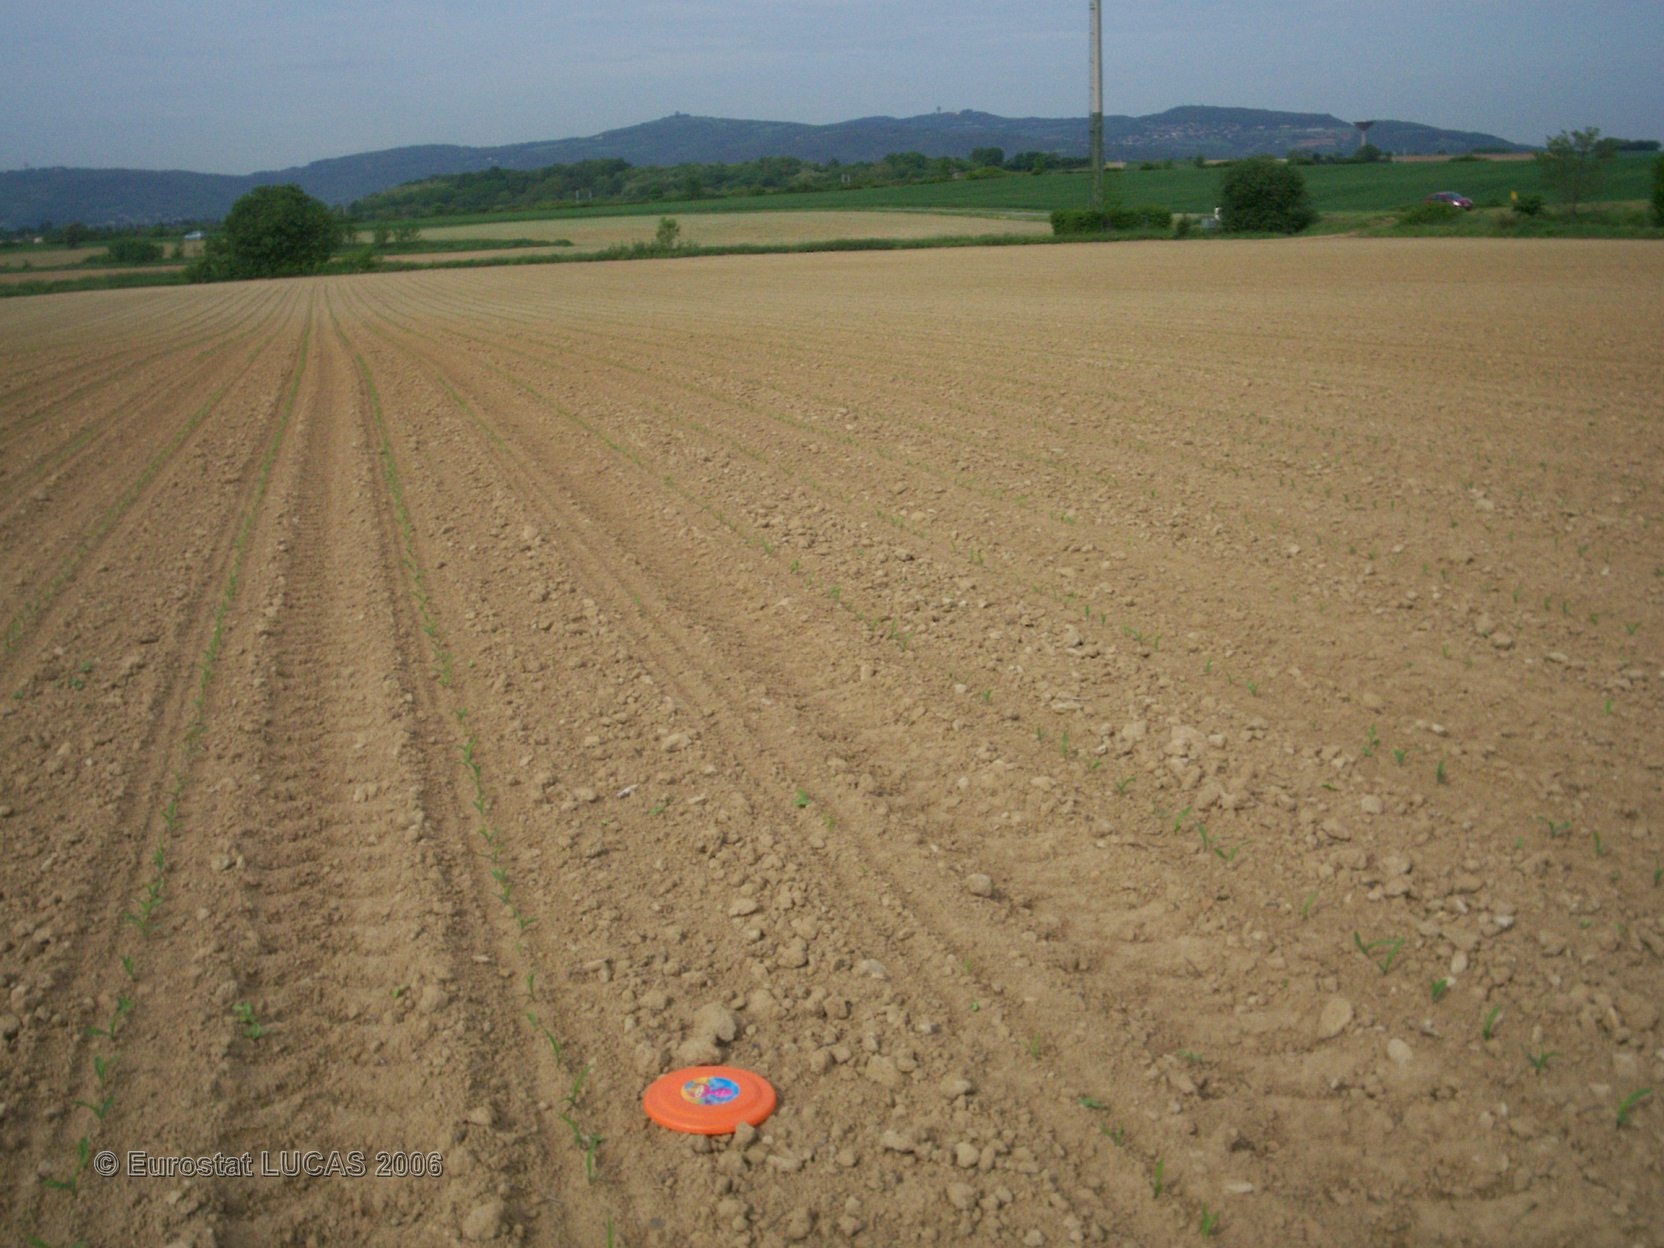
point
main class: Cropland
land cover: Maize
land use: Agriculture (excluding fallow land and kitchen gardens)
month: May
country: FR
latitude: 45.8681
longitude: 4.8893
